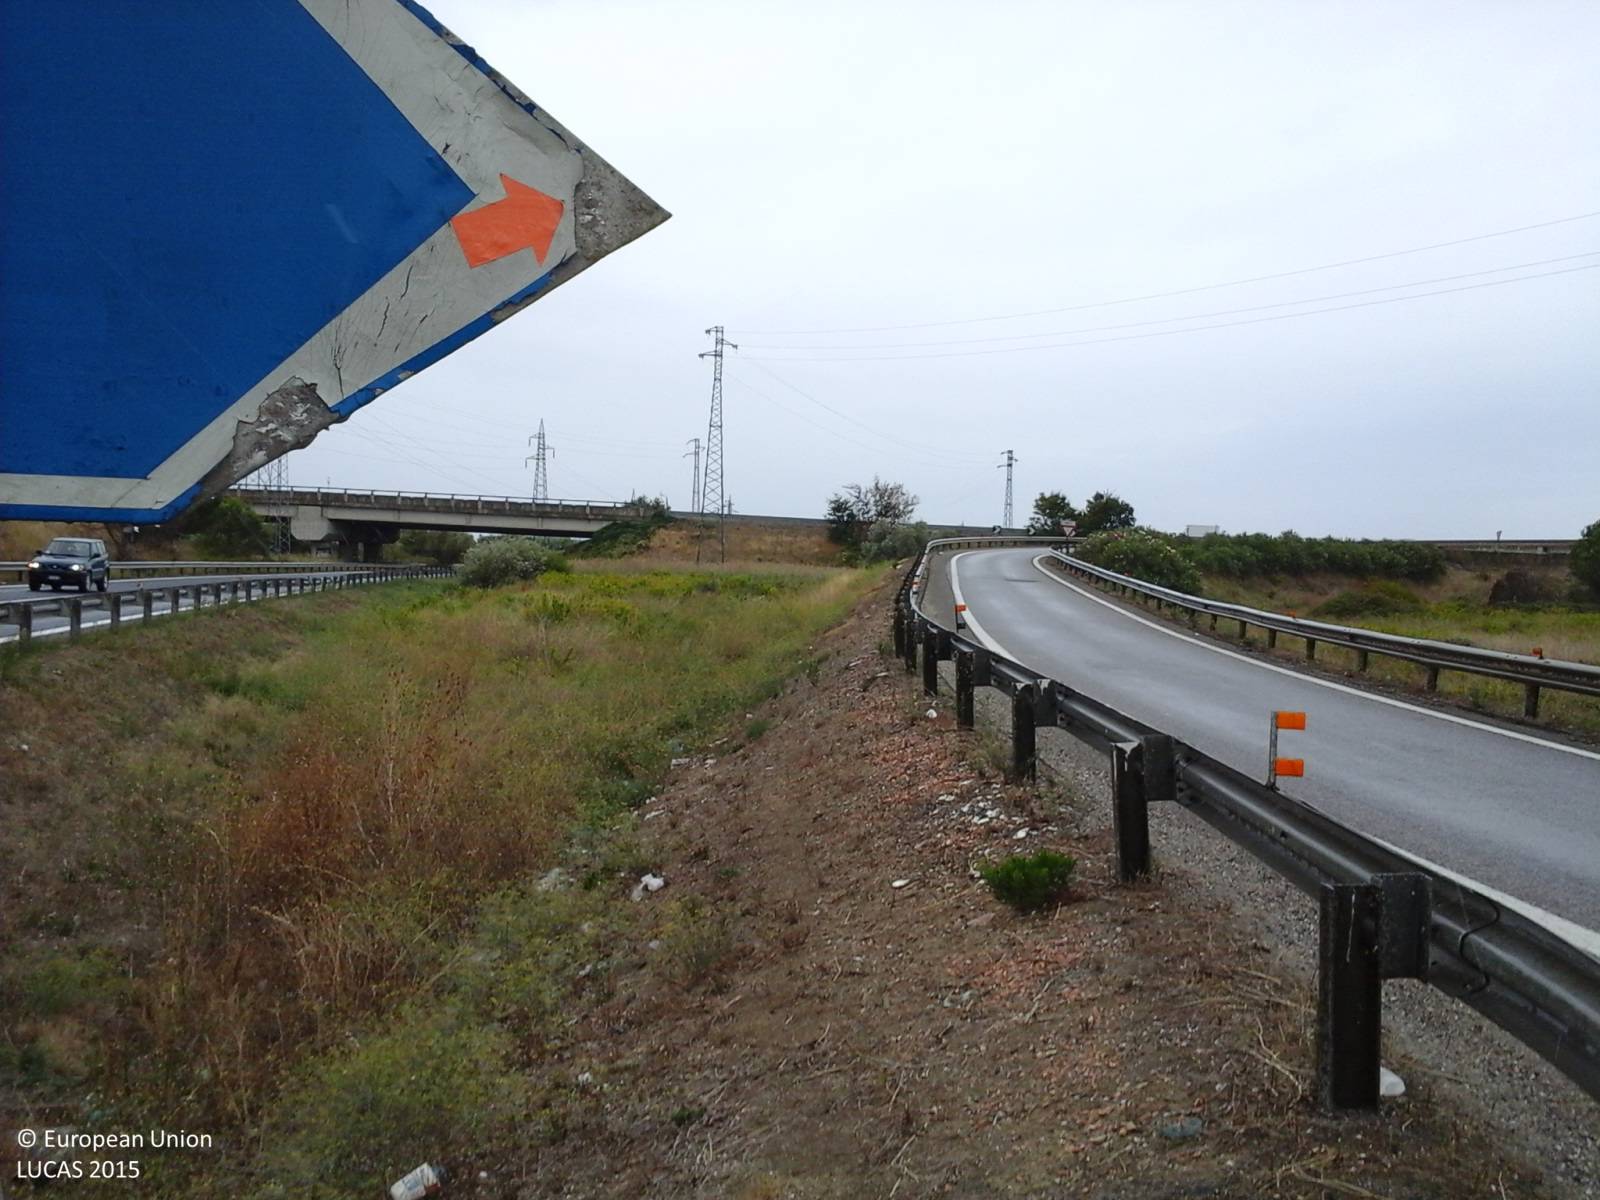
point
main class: Grassland
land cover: Grassland without tree/shrub cover
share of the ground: > 75 %
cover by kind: herbaceous plants 100 %
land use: Road transport
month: October
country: IT
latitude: 43.0134
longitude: 10.5993
